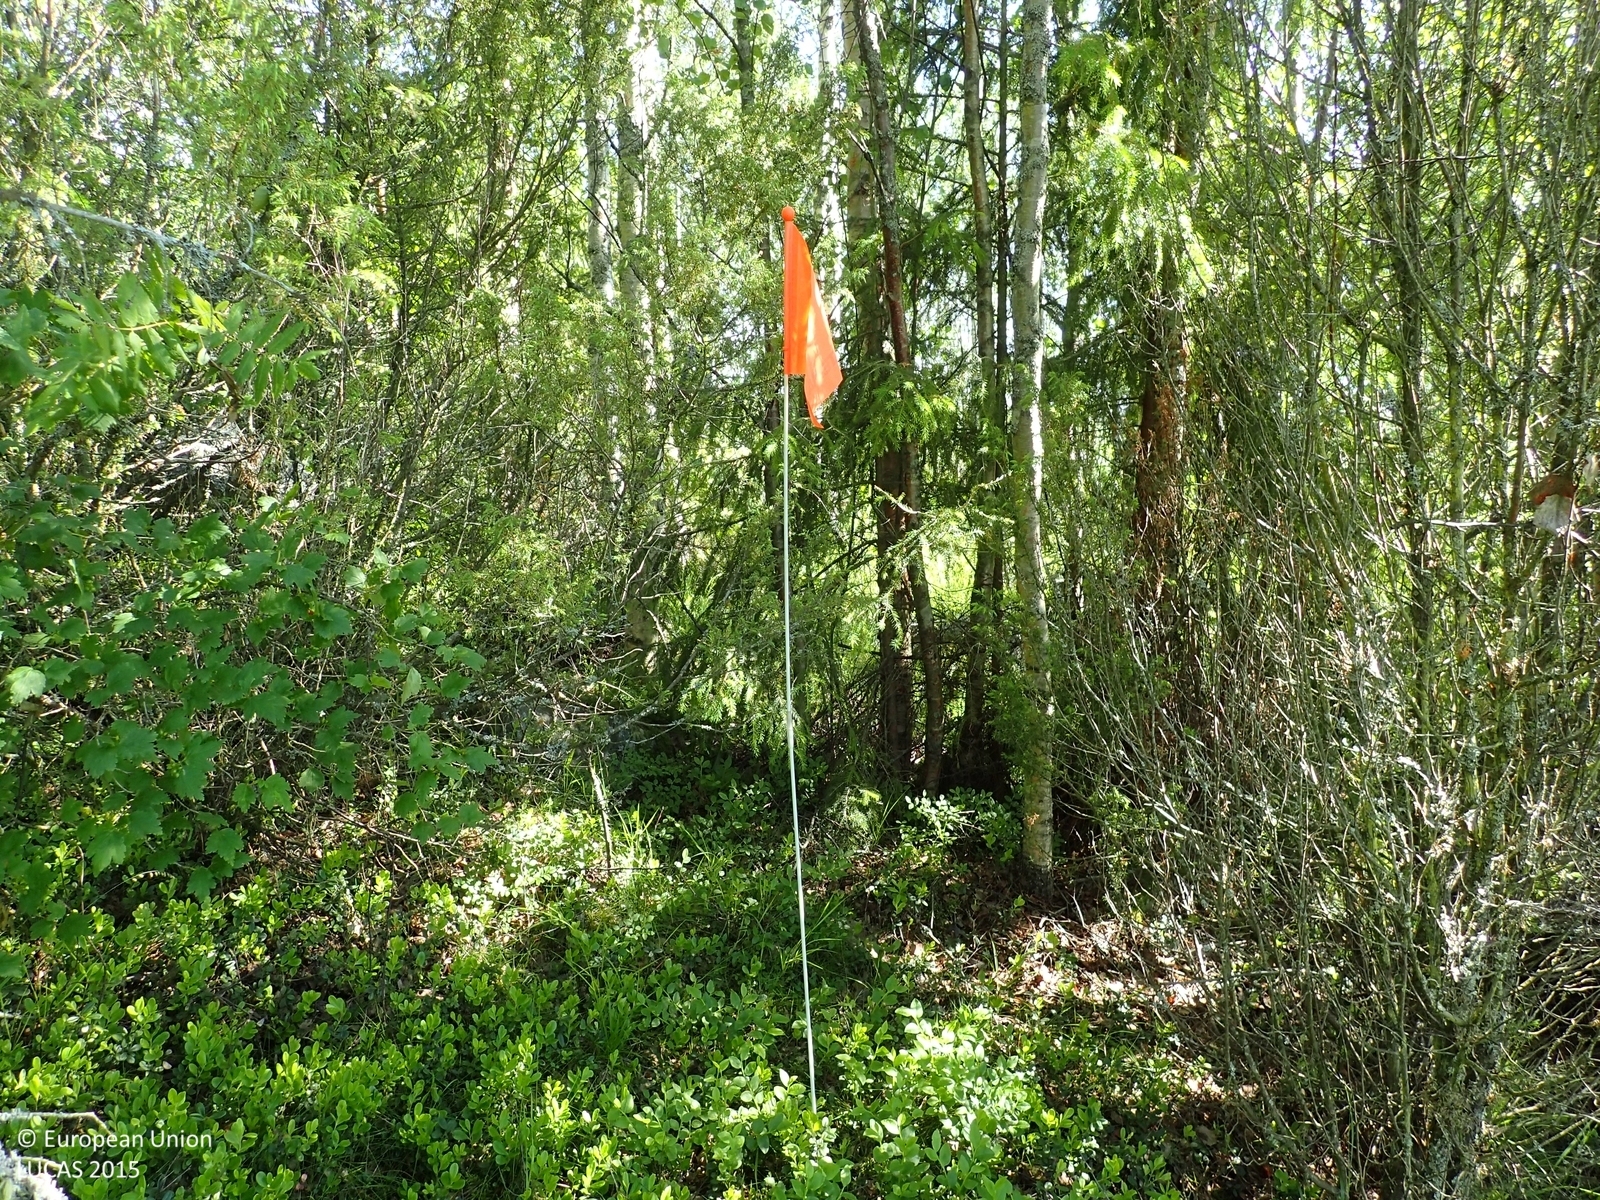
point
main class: Woodland
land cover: Other mixed woodland
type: boreal forest
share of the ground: > 75 %
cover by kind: coniferous forest trees 60 %, broadleaved forest trees 20 %, shrubs 15 %, herbaceous plants 5 %
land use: Forestry
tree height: > 5 m
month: June
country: FI
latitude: 62.4797
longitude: 21.2733
